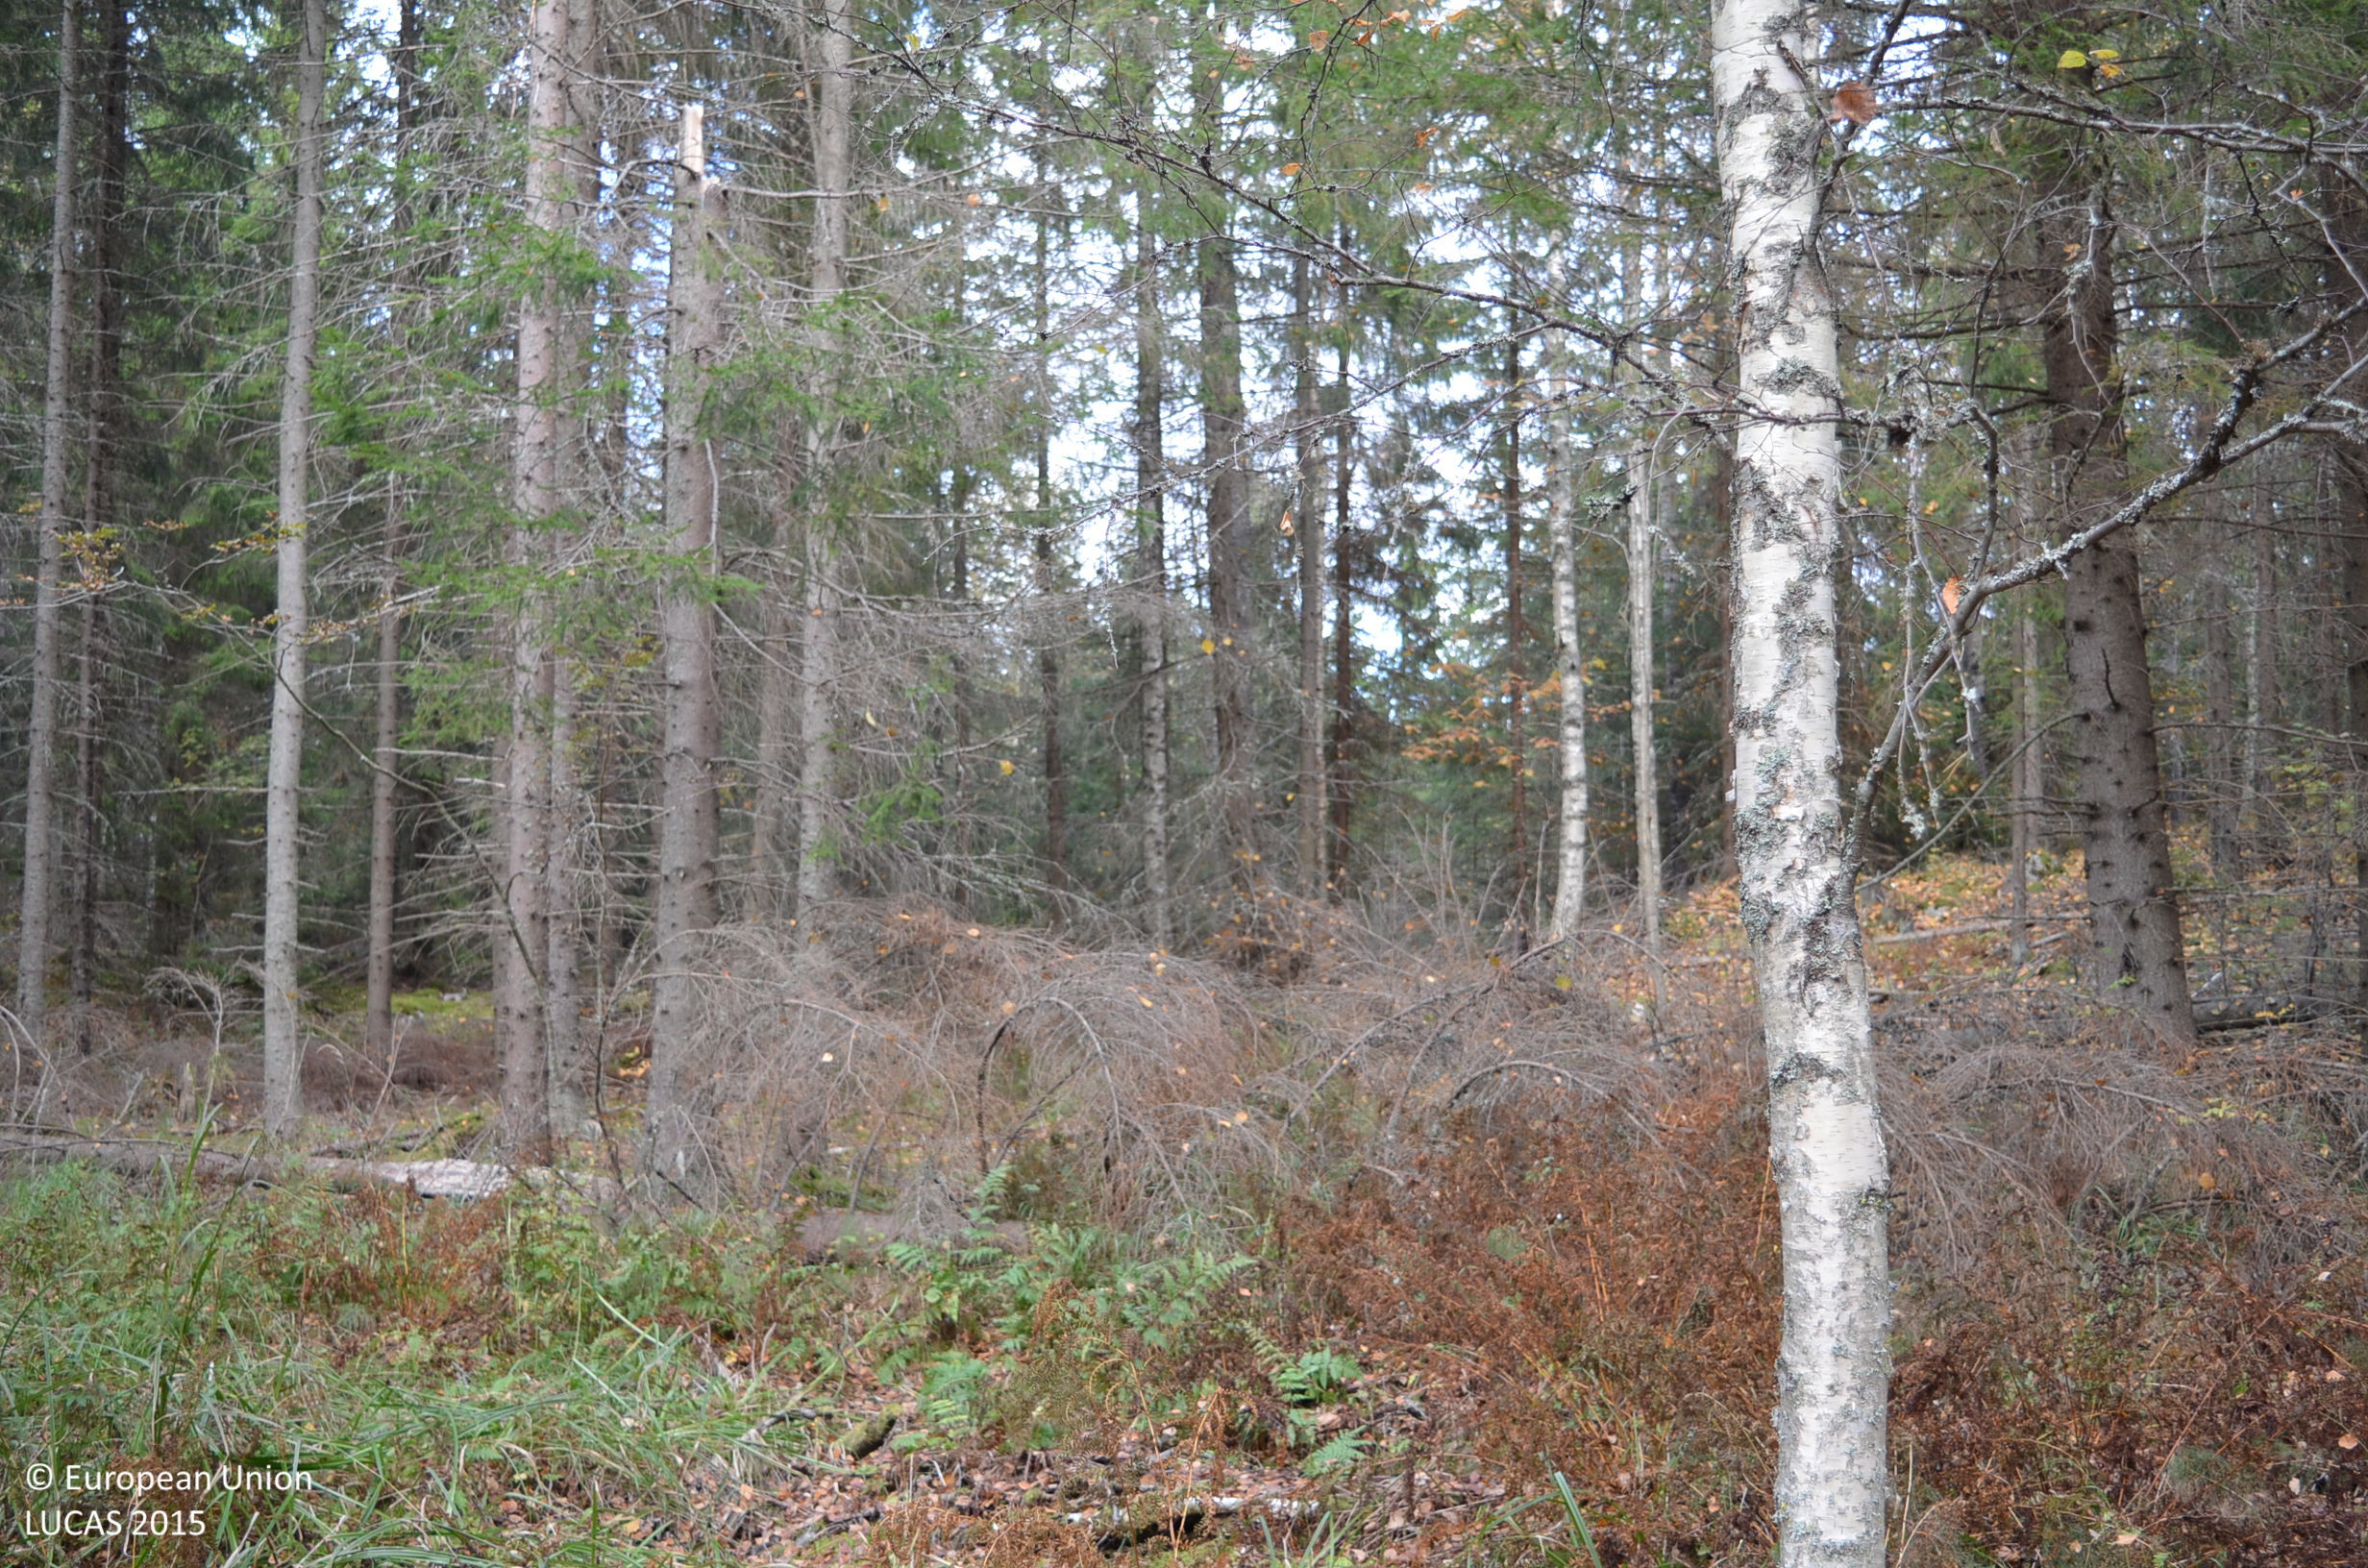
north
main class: Woodland
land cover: Spruce dominated mixed woodland
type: boreal forest
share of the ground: 50 - 75 %
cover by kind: coniferous forest trees 35 %, broadleaved forest trees 35 %, herbaceous plants 25 %, shrubs 5 %
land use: Forestry
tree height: > 5 m
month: October
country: FI
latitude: 61.6914
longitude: 23.8647
